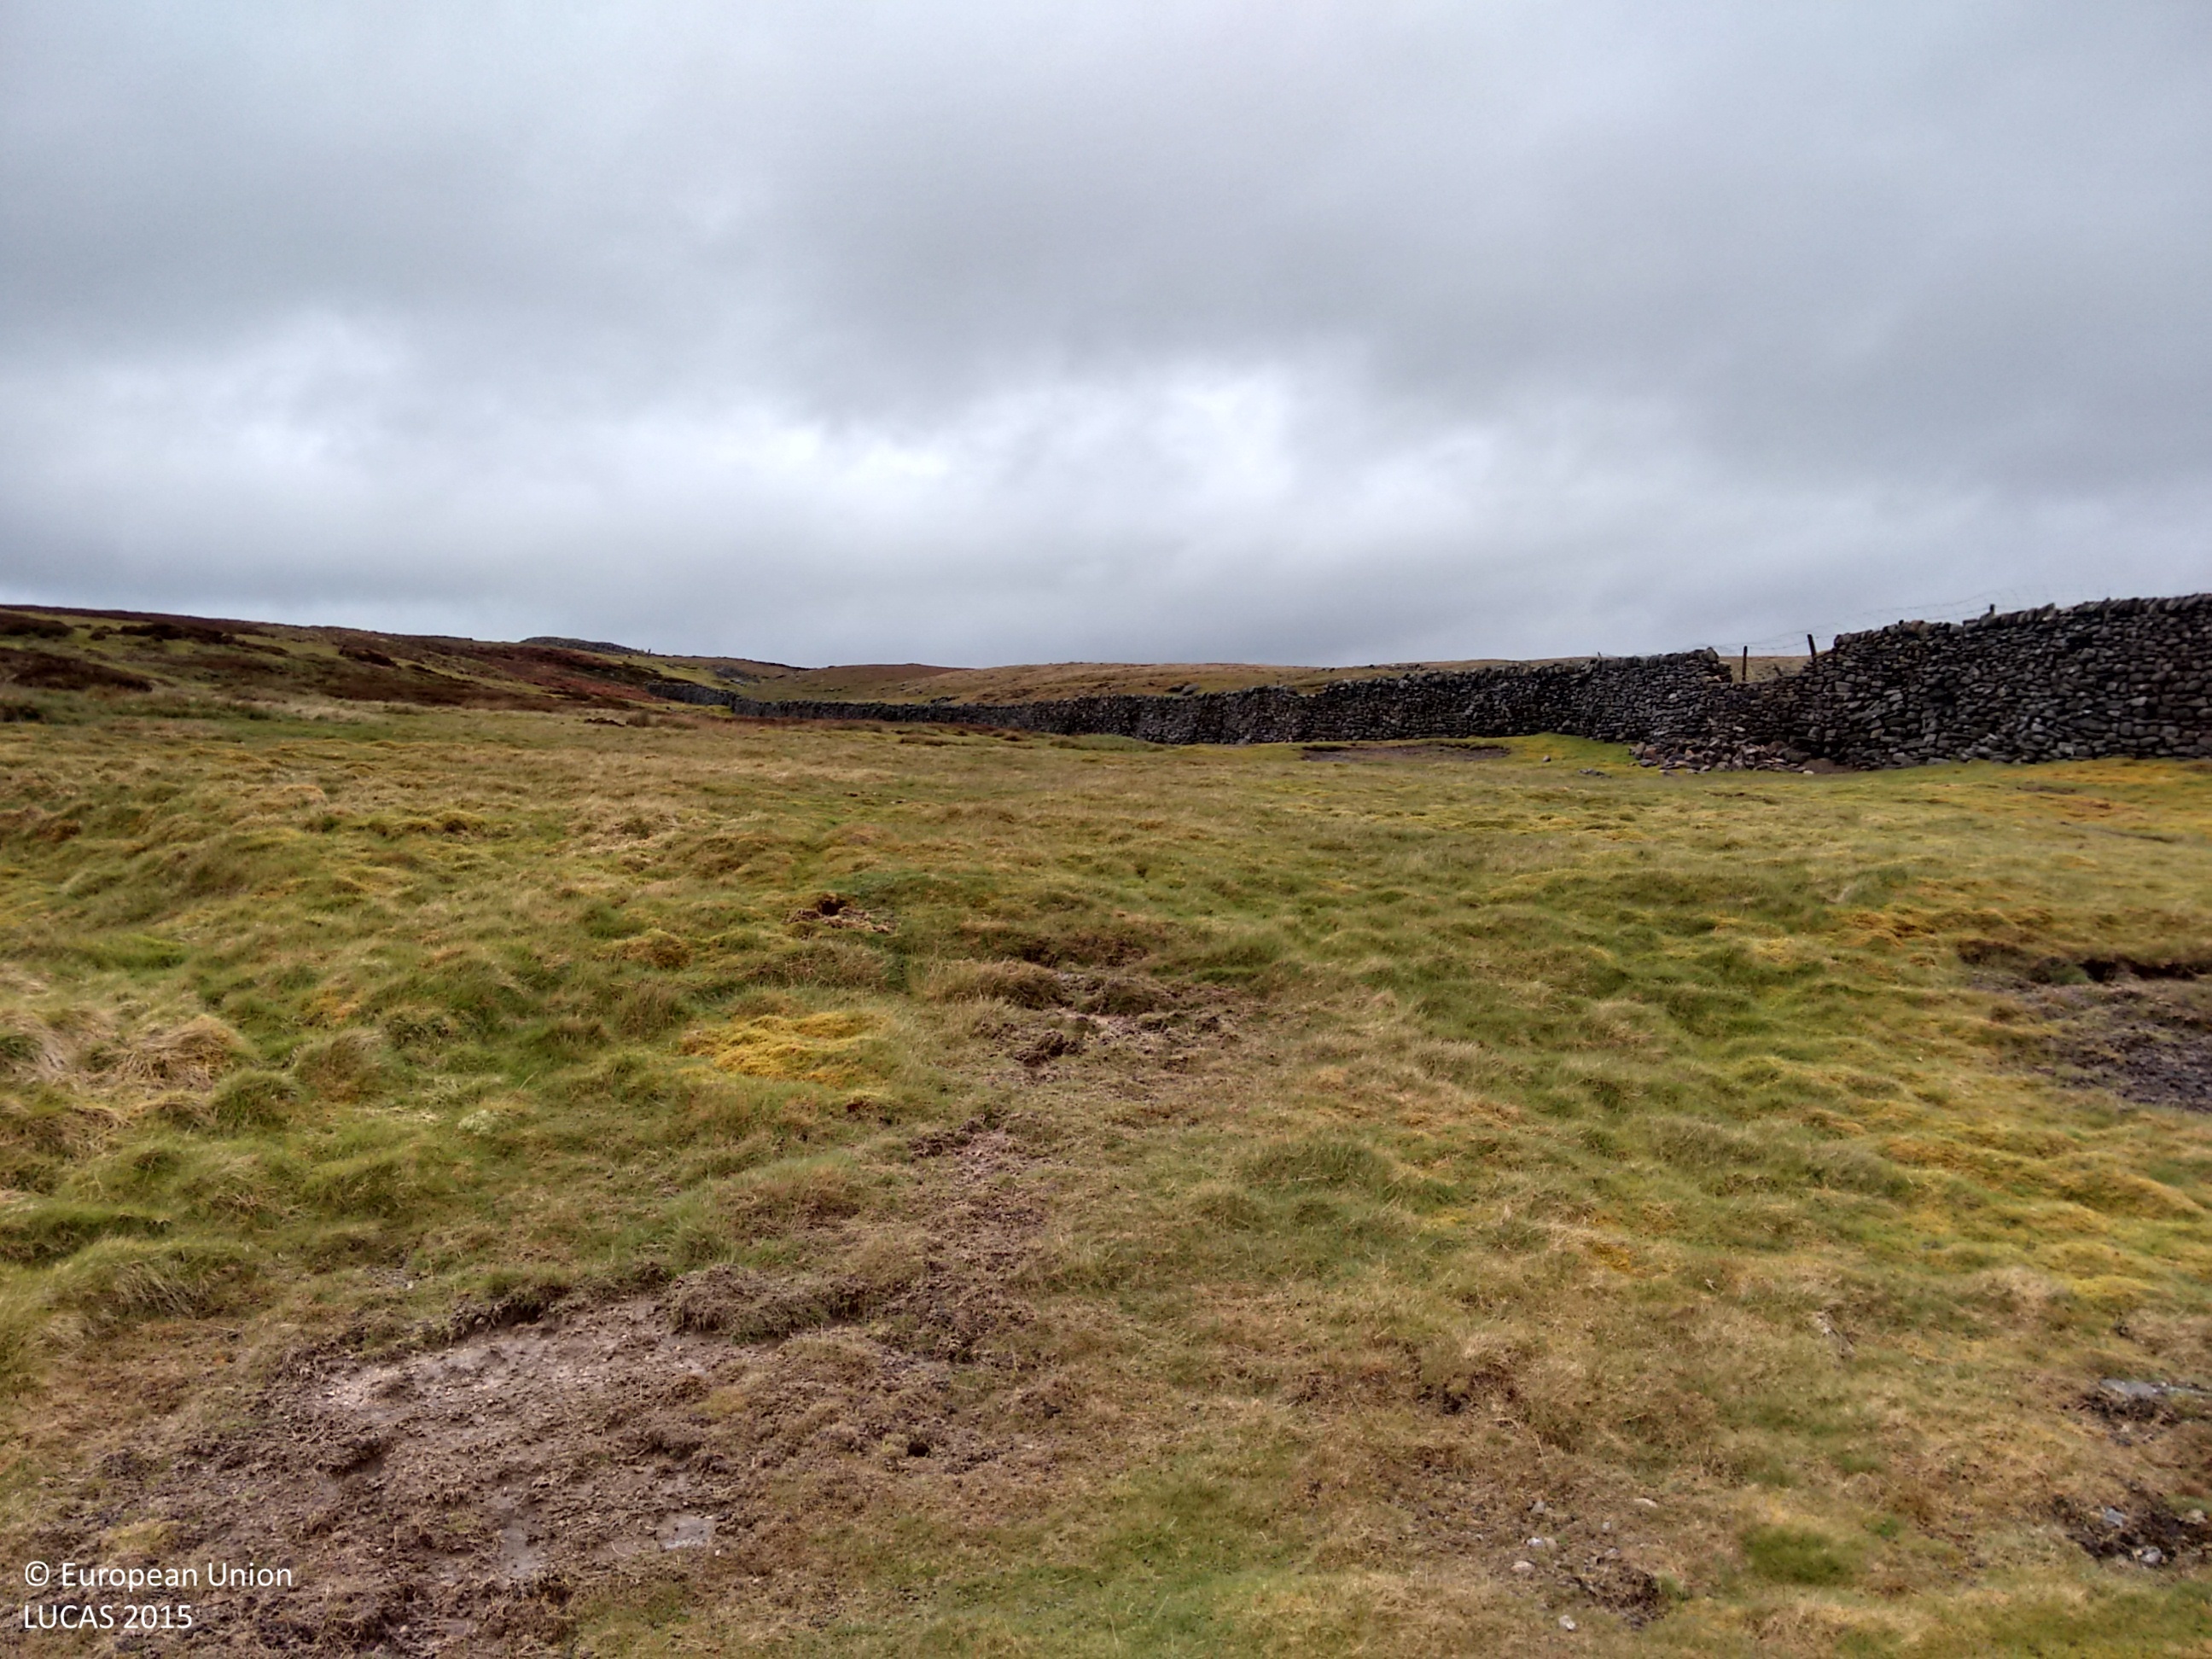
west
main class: Grassland
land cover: Grassland without tree/shrub cover
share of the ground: > 75 %
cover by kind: herbaceous plants 100 %
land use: Agriculture (excluding fallow land and kitchen gardens)
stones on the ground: < 10 %
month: June
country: GB
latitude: 54.0970
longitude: -1.9679
